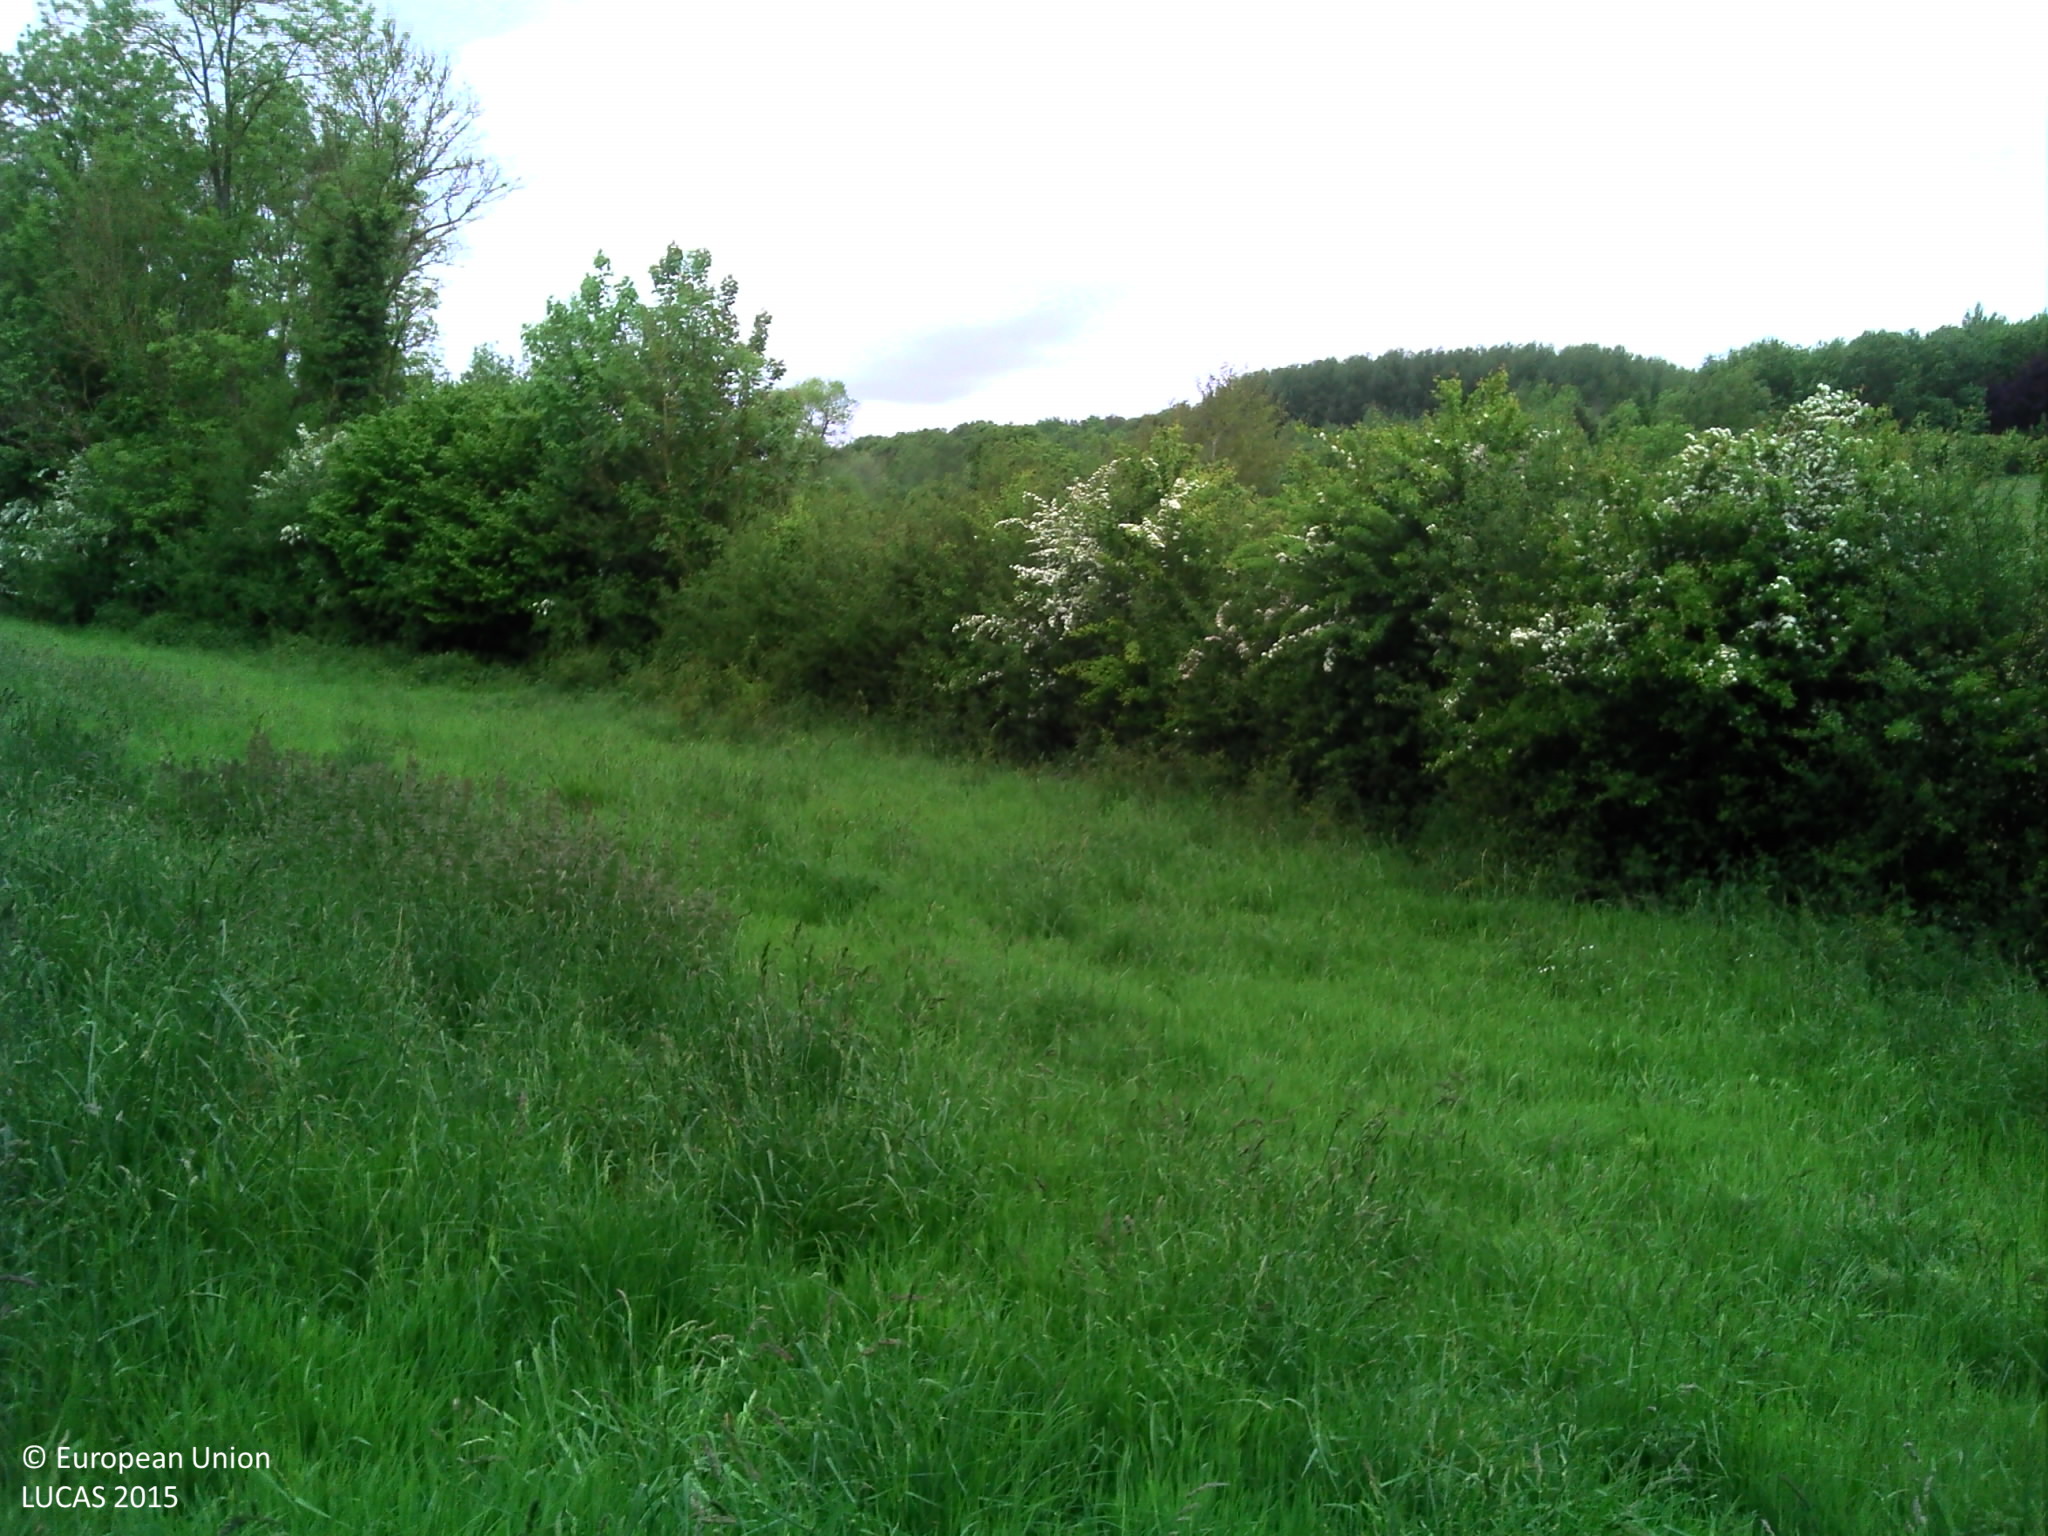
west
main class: Grassland
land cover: Grassland without tree/shrub cover
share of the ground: > 75 %
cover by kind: herbaceous plants 100 %
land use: Agriculture (excluding fallow land and kitchen gardens)
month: May
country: FR
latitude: 50.5063
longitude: 2.1029
